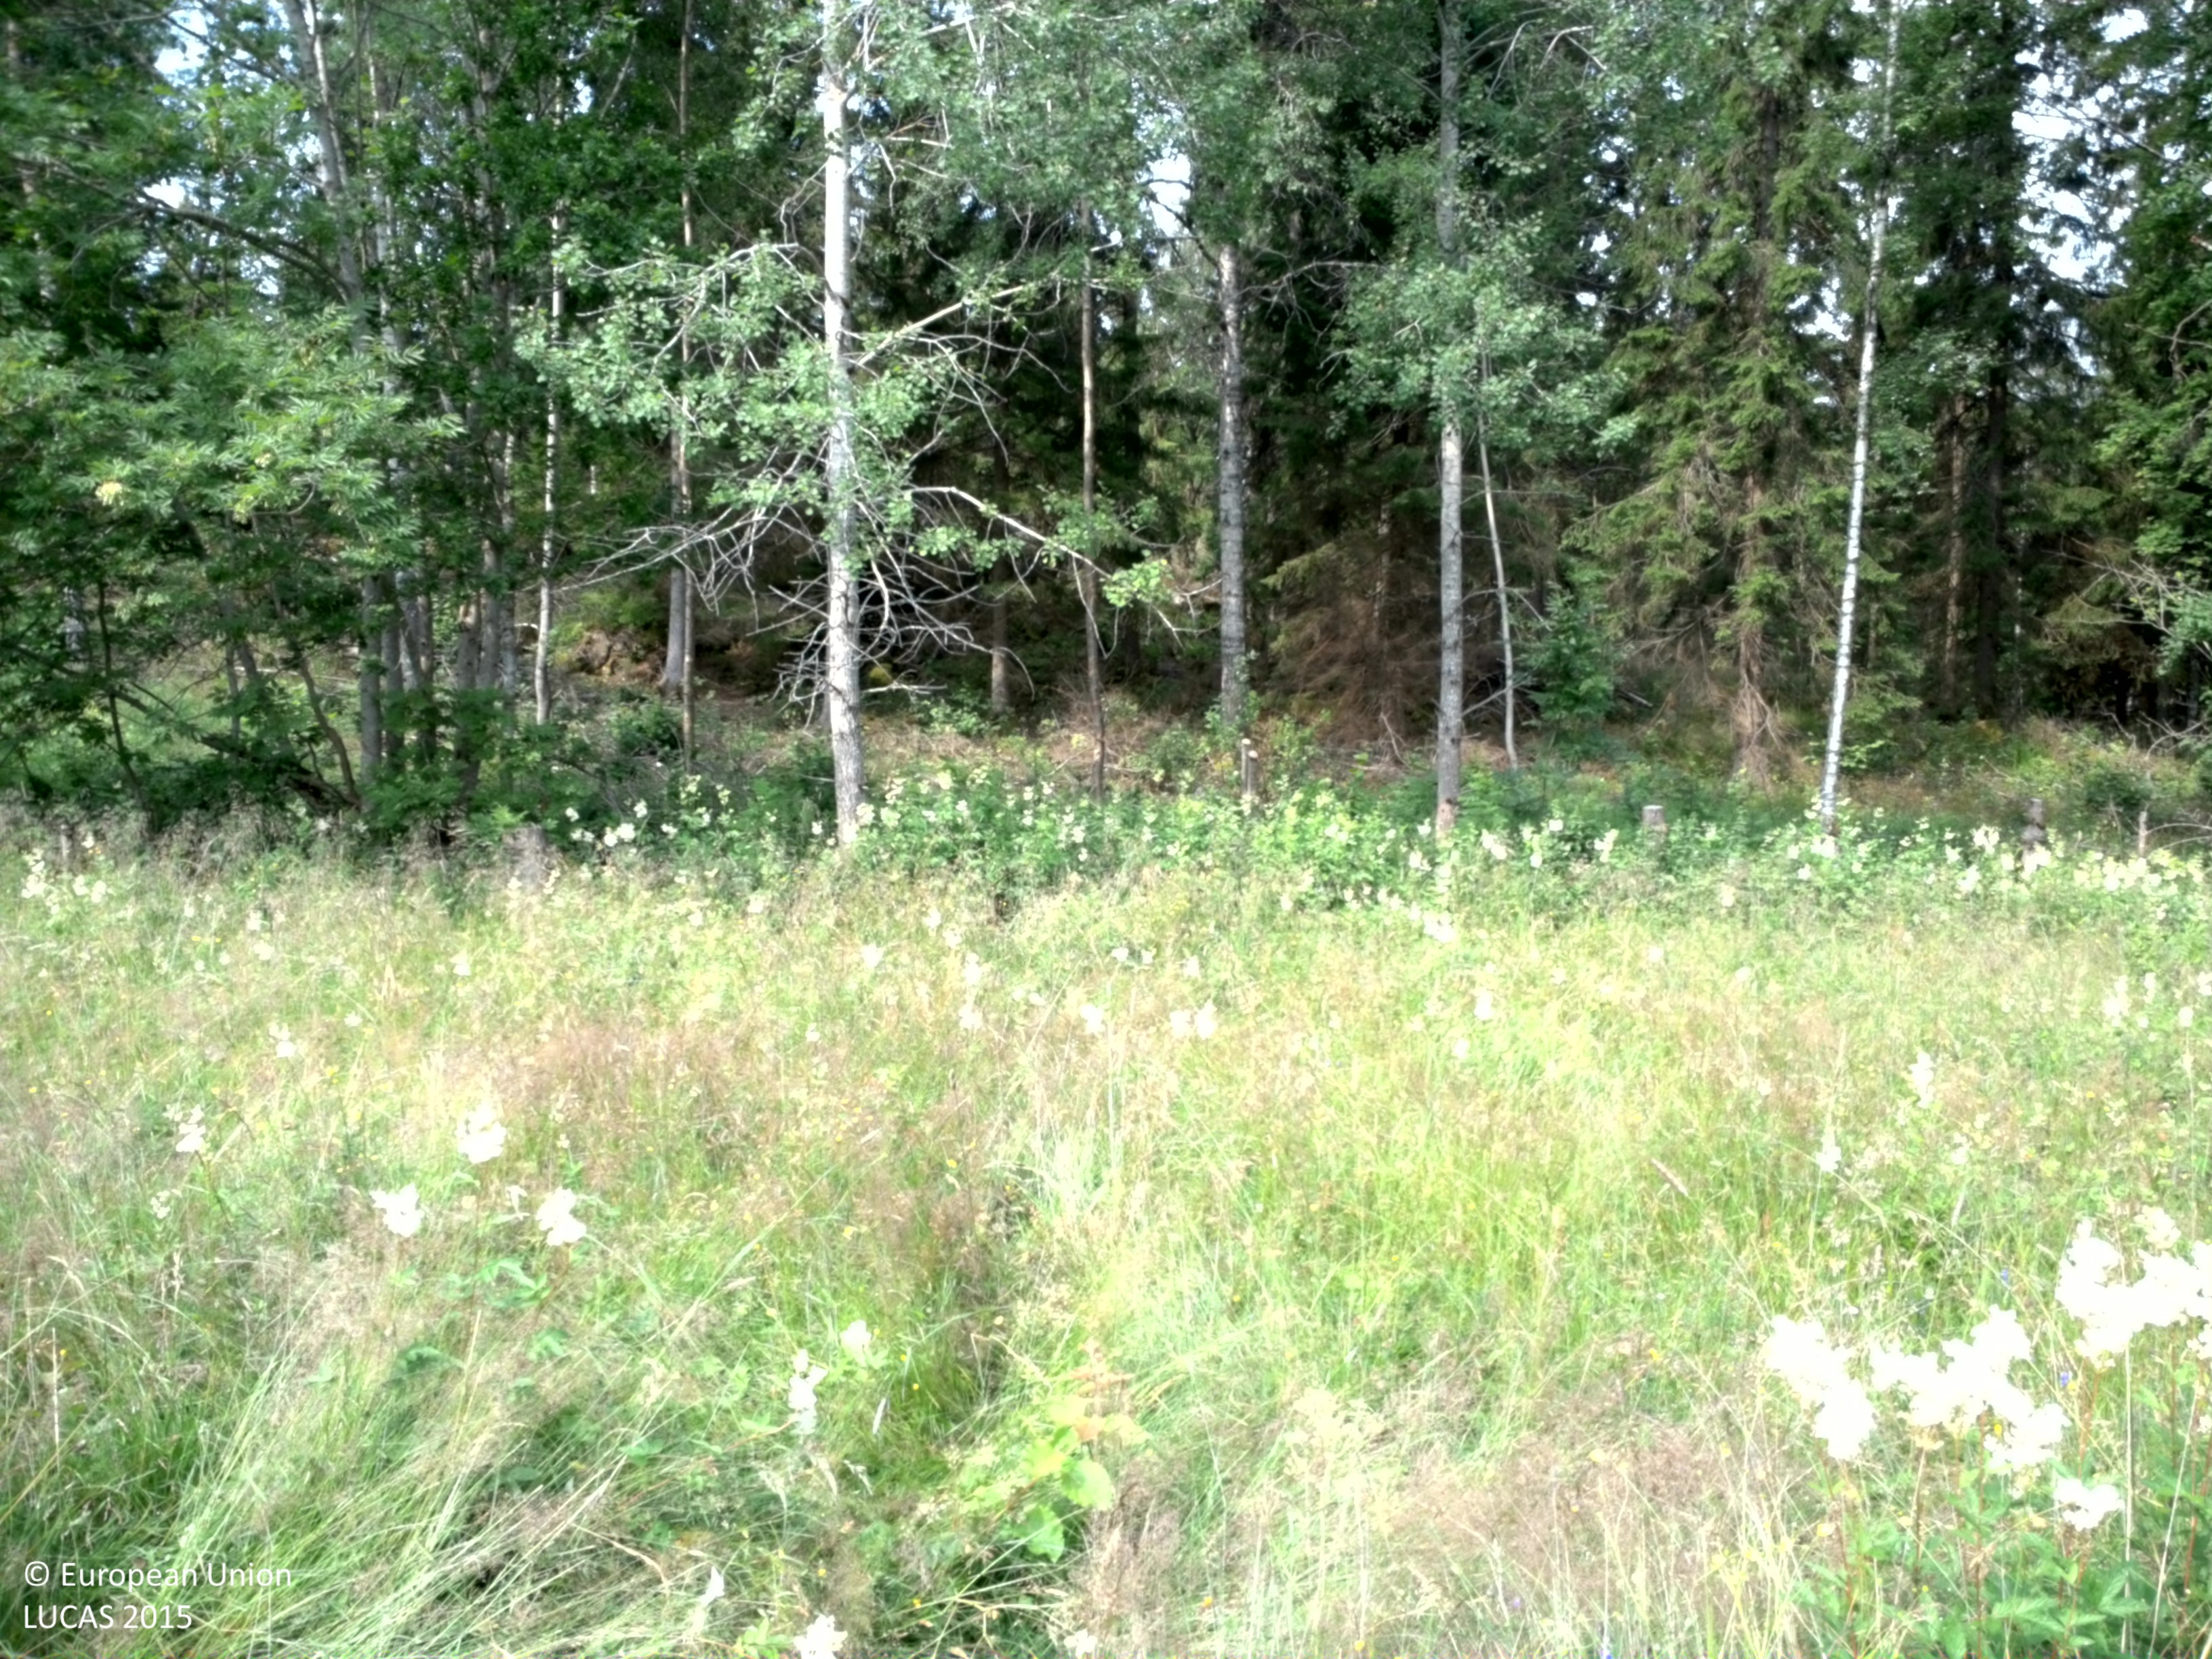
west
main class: Grassland
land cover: Grassland with sparse tree/shrub cover
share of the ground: > 75 %
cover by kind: herbaceous plants 90 %, broadleaved forest trees 5 %, shrubs 5 %
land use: Agriculture (excluding fallow land and kitchen gardens)
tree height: < 5 m
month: July
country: SE
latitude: 58.6715
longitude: 14.3557
